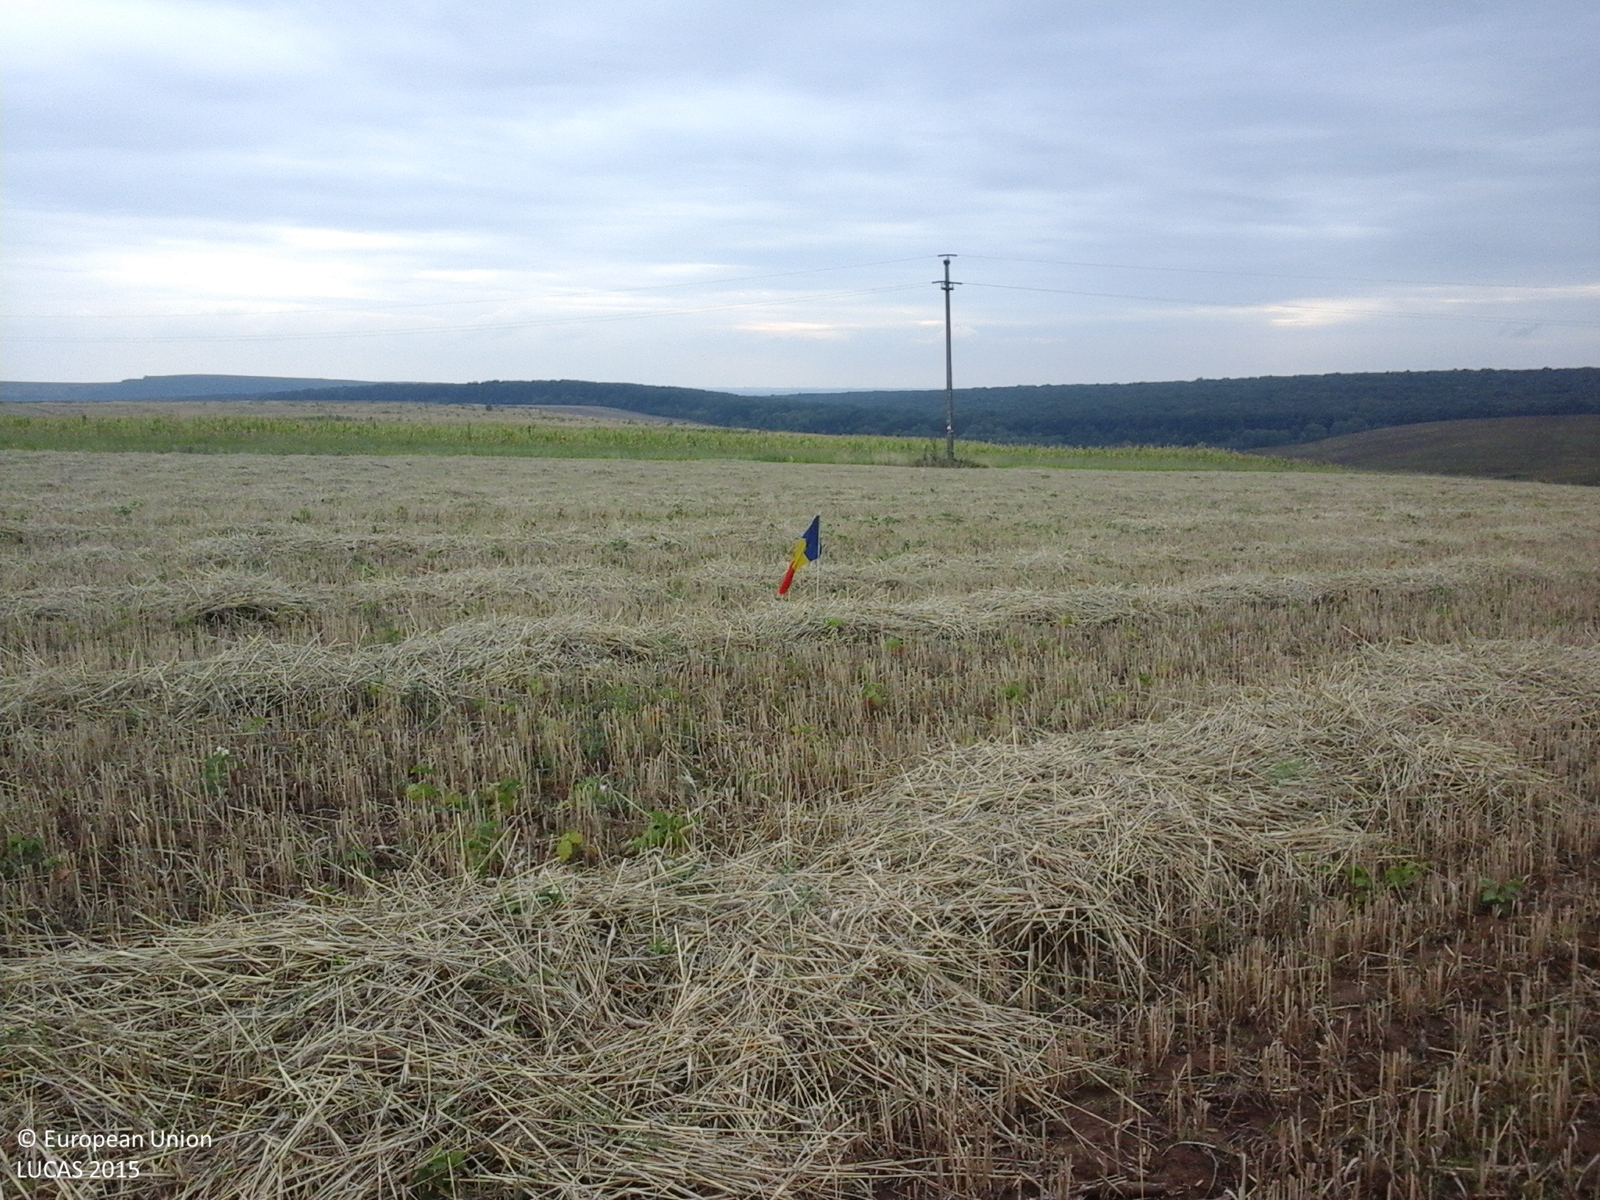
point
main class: Cropland
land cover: Durum wheat
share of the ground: > 75 %
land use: Agriculture (excluding fallow land and kitchen gardens)
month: August
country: RO
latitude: 45.8728
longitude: 21.5133
